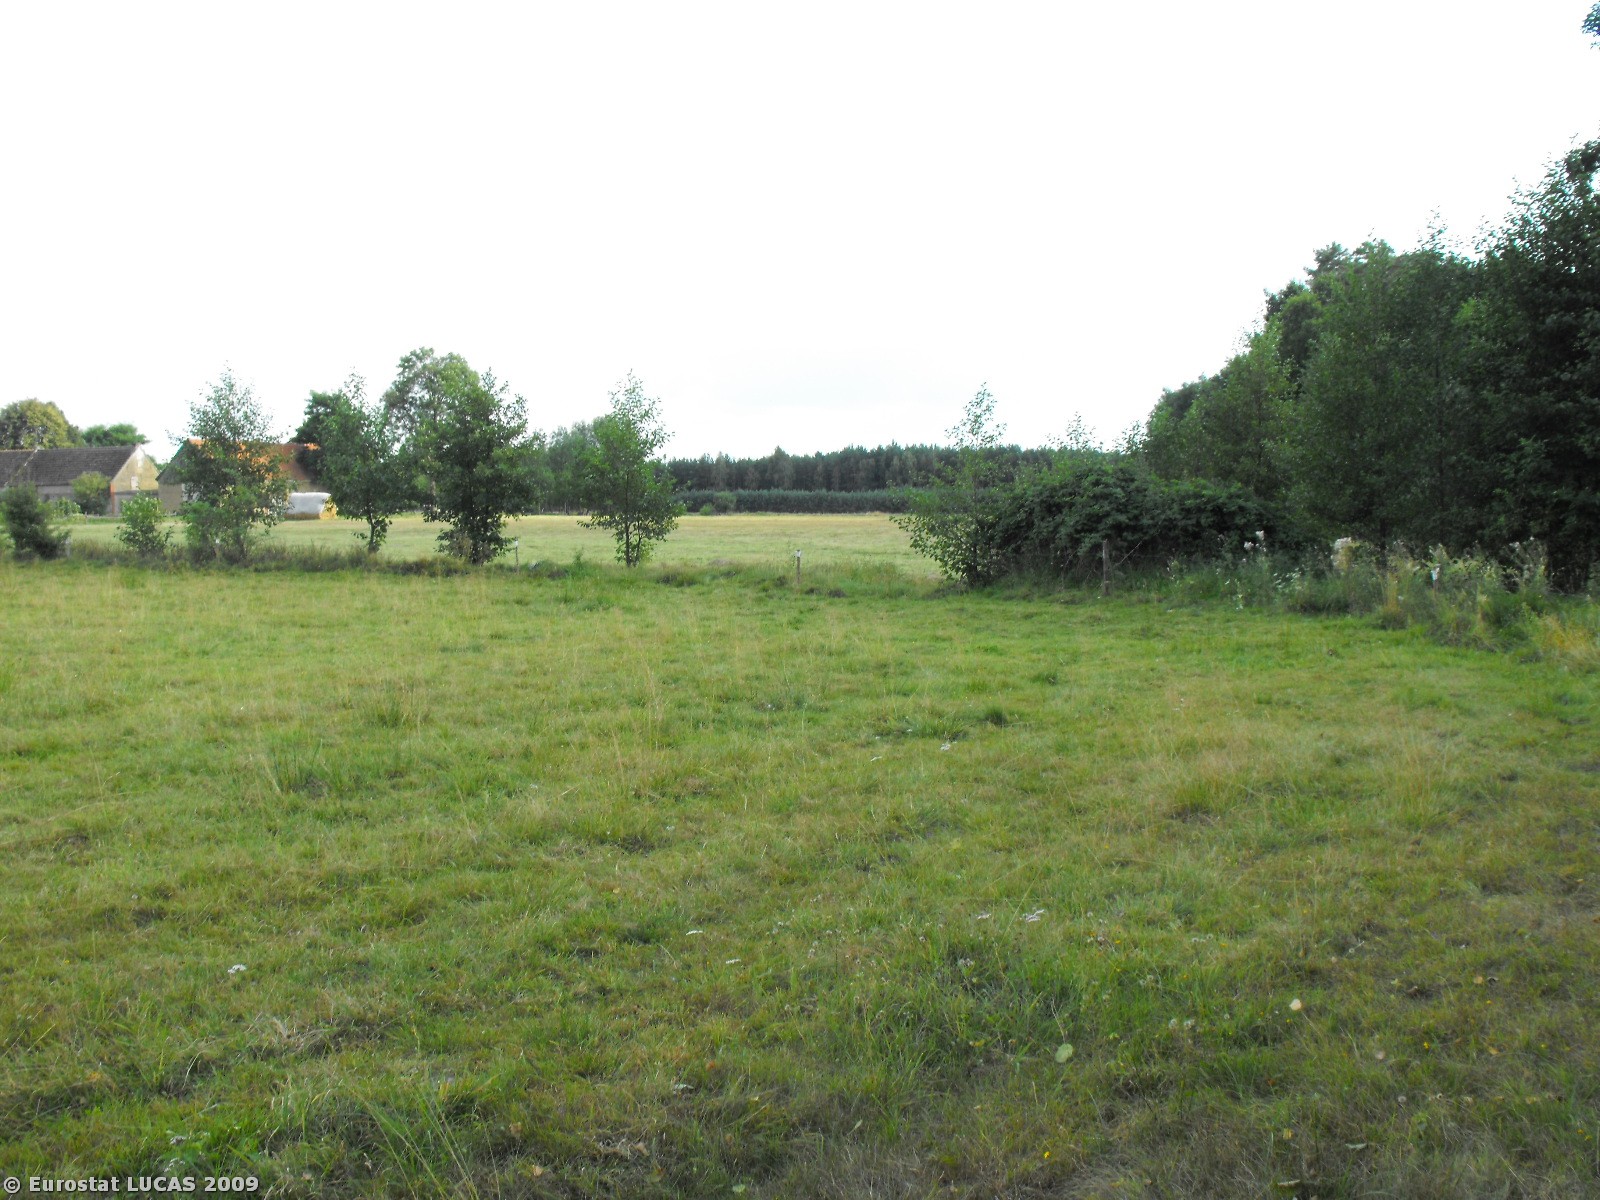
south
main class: Grassland
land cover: Grassland without tree/shrub cover
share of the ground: > 75 %
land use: Agriculture (excluding fallow land and kitchen gardens)
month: August
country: PL
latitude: 52.9399
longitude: 16.4799
